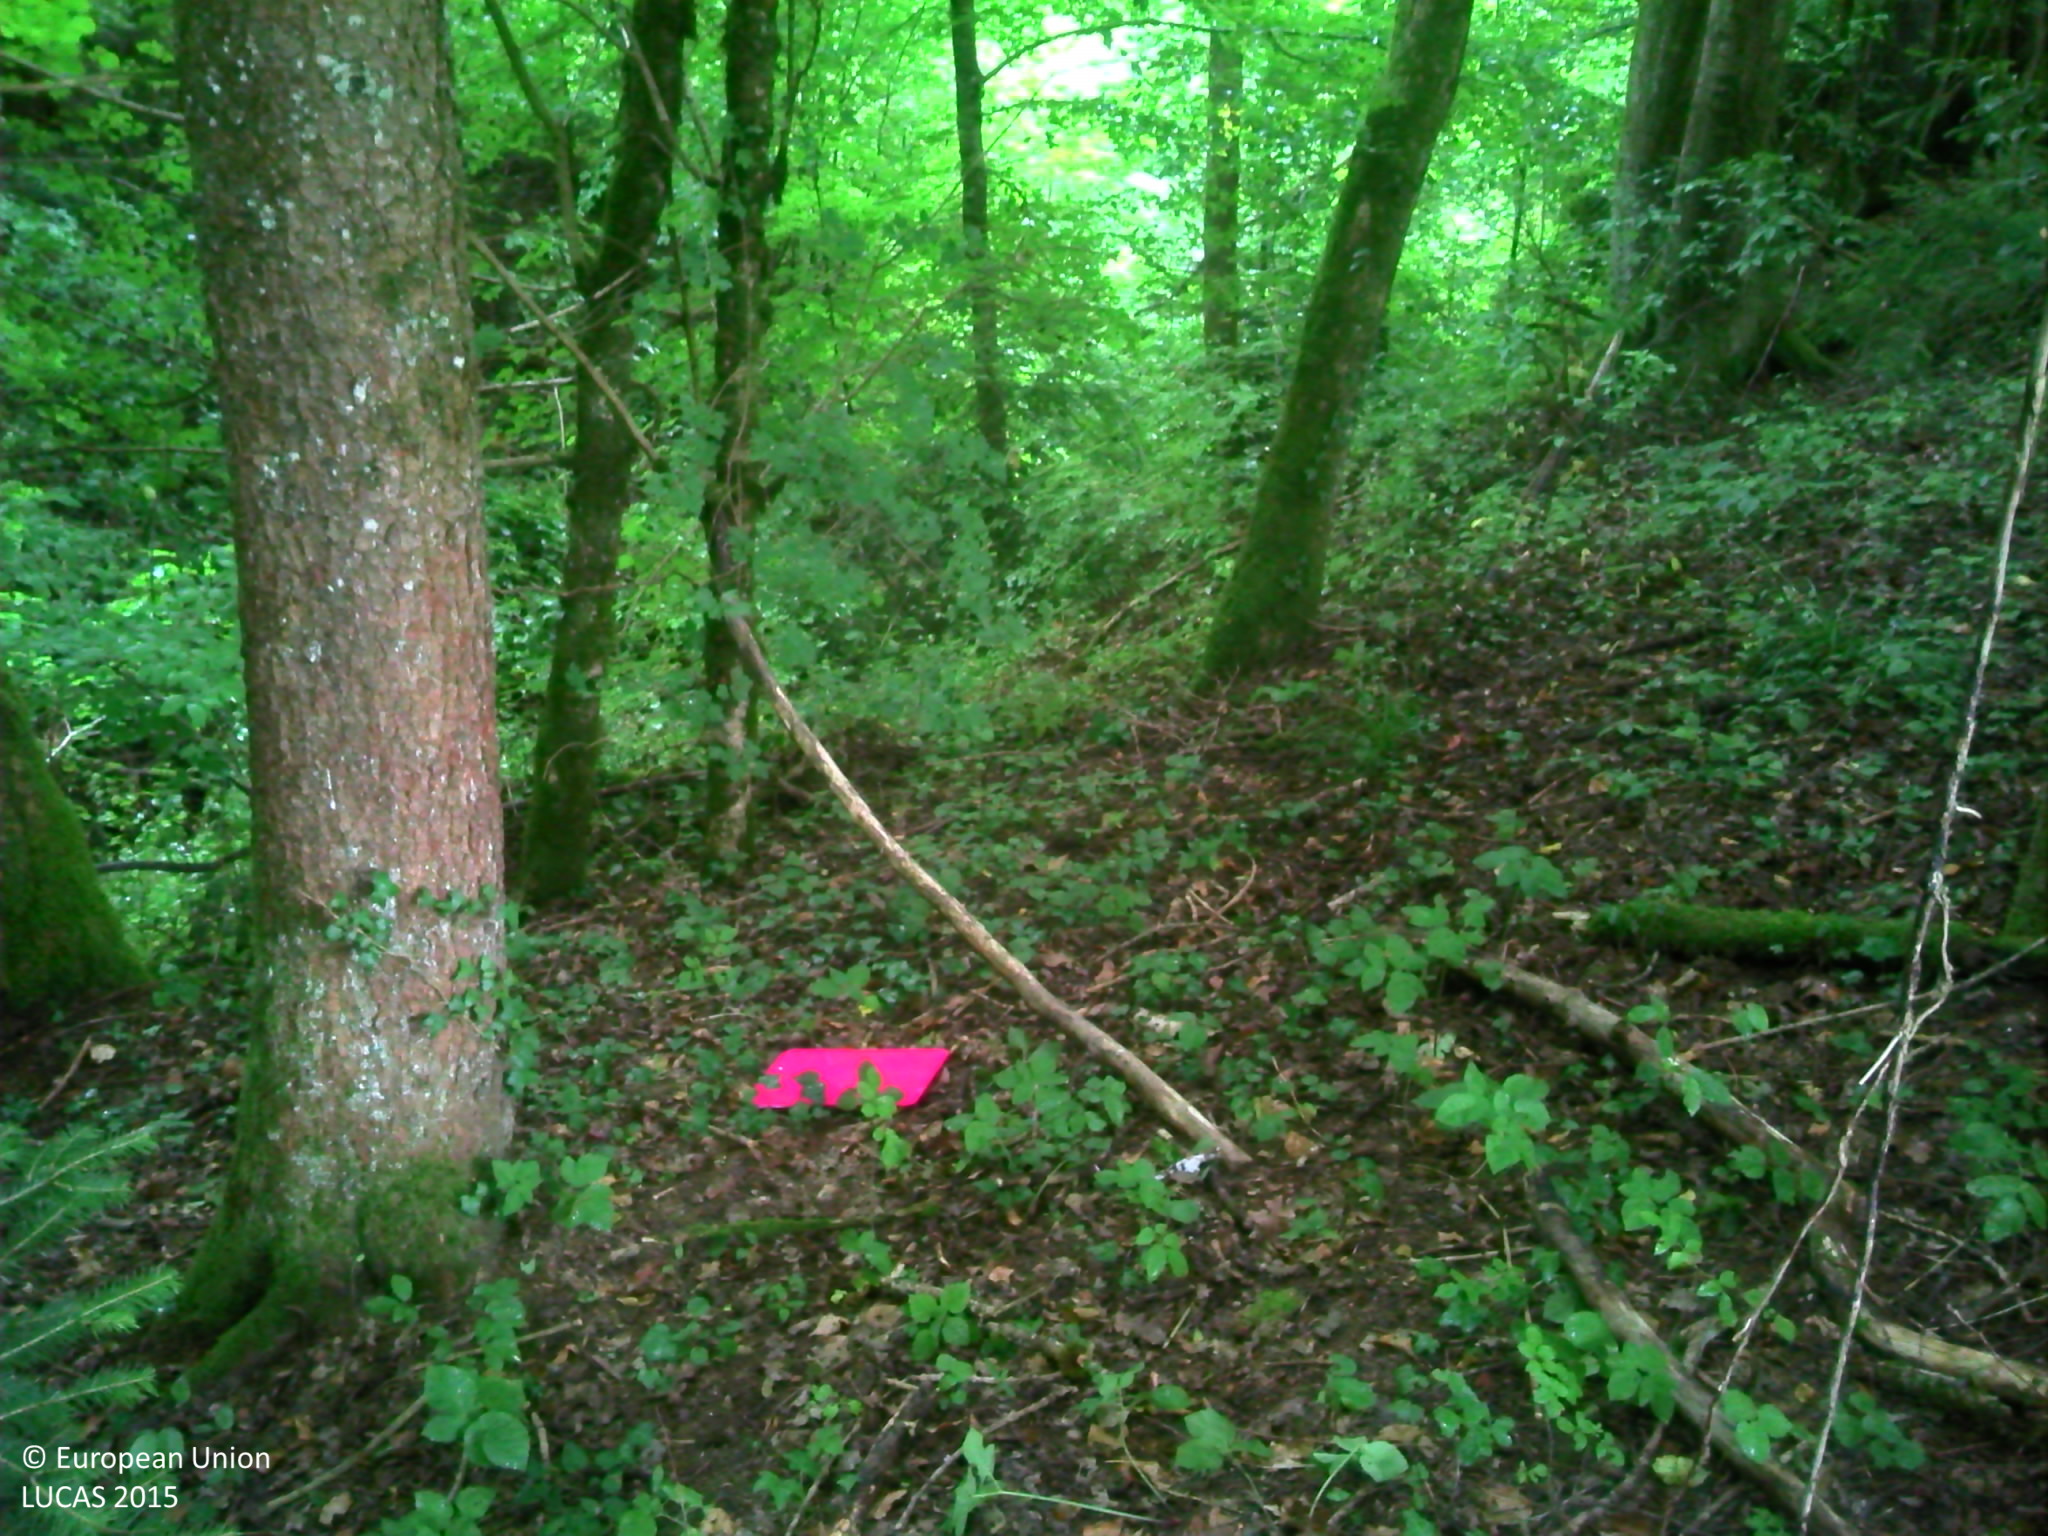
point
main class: Woodland
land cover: Broadleaved woodland
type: beech forest
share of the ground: > 75 %
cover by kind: broadleaved forest trees 65 %, coniferous forest trees 15 %, herbaceous plants 15 %, lichens and mosses 5 %
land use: Semi-natural and natural areas not in use
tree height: > 5 m
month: July
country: FR
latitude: 45.9770
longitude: 6.1963
